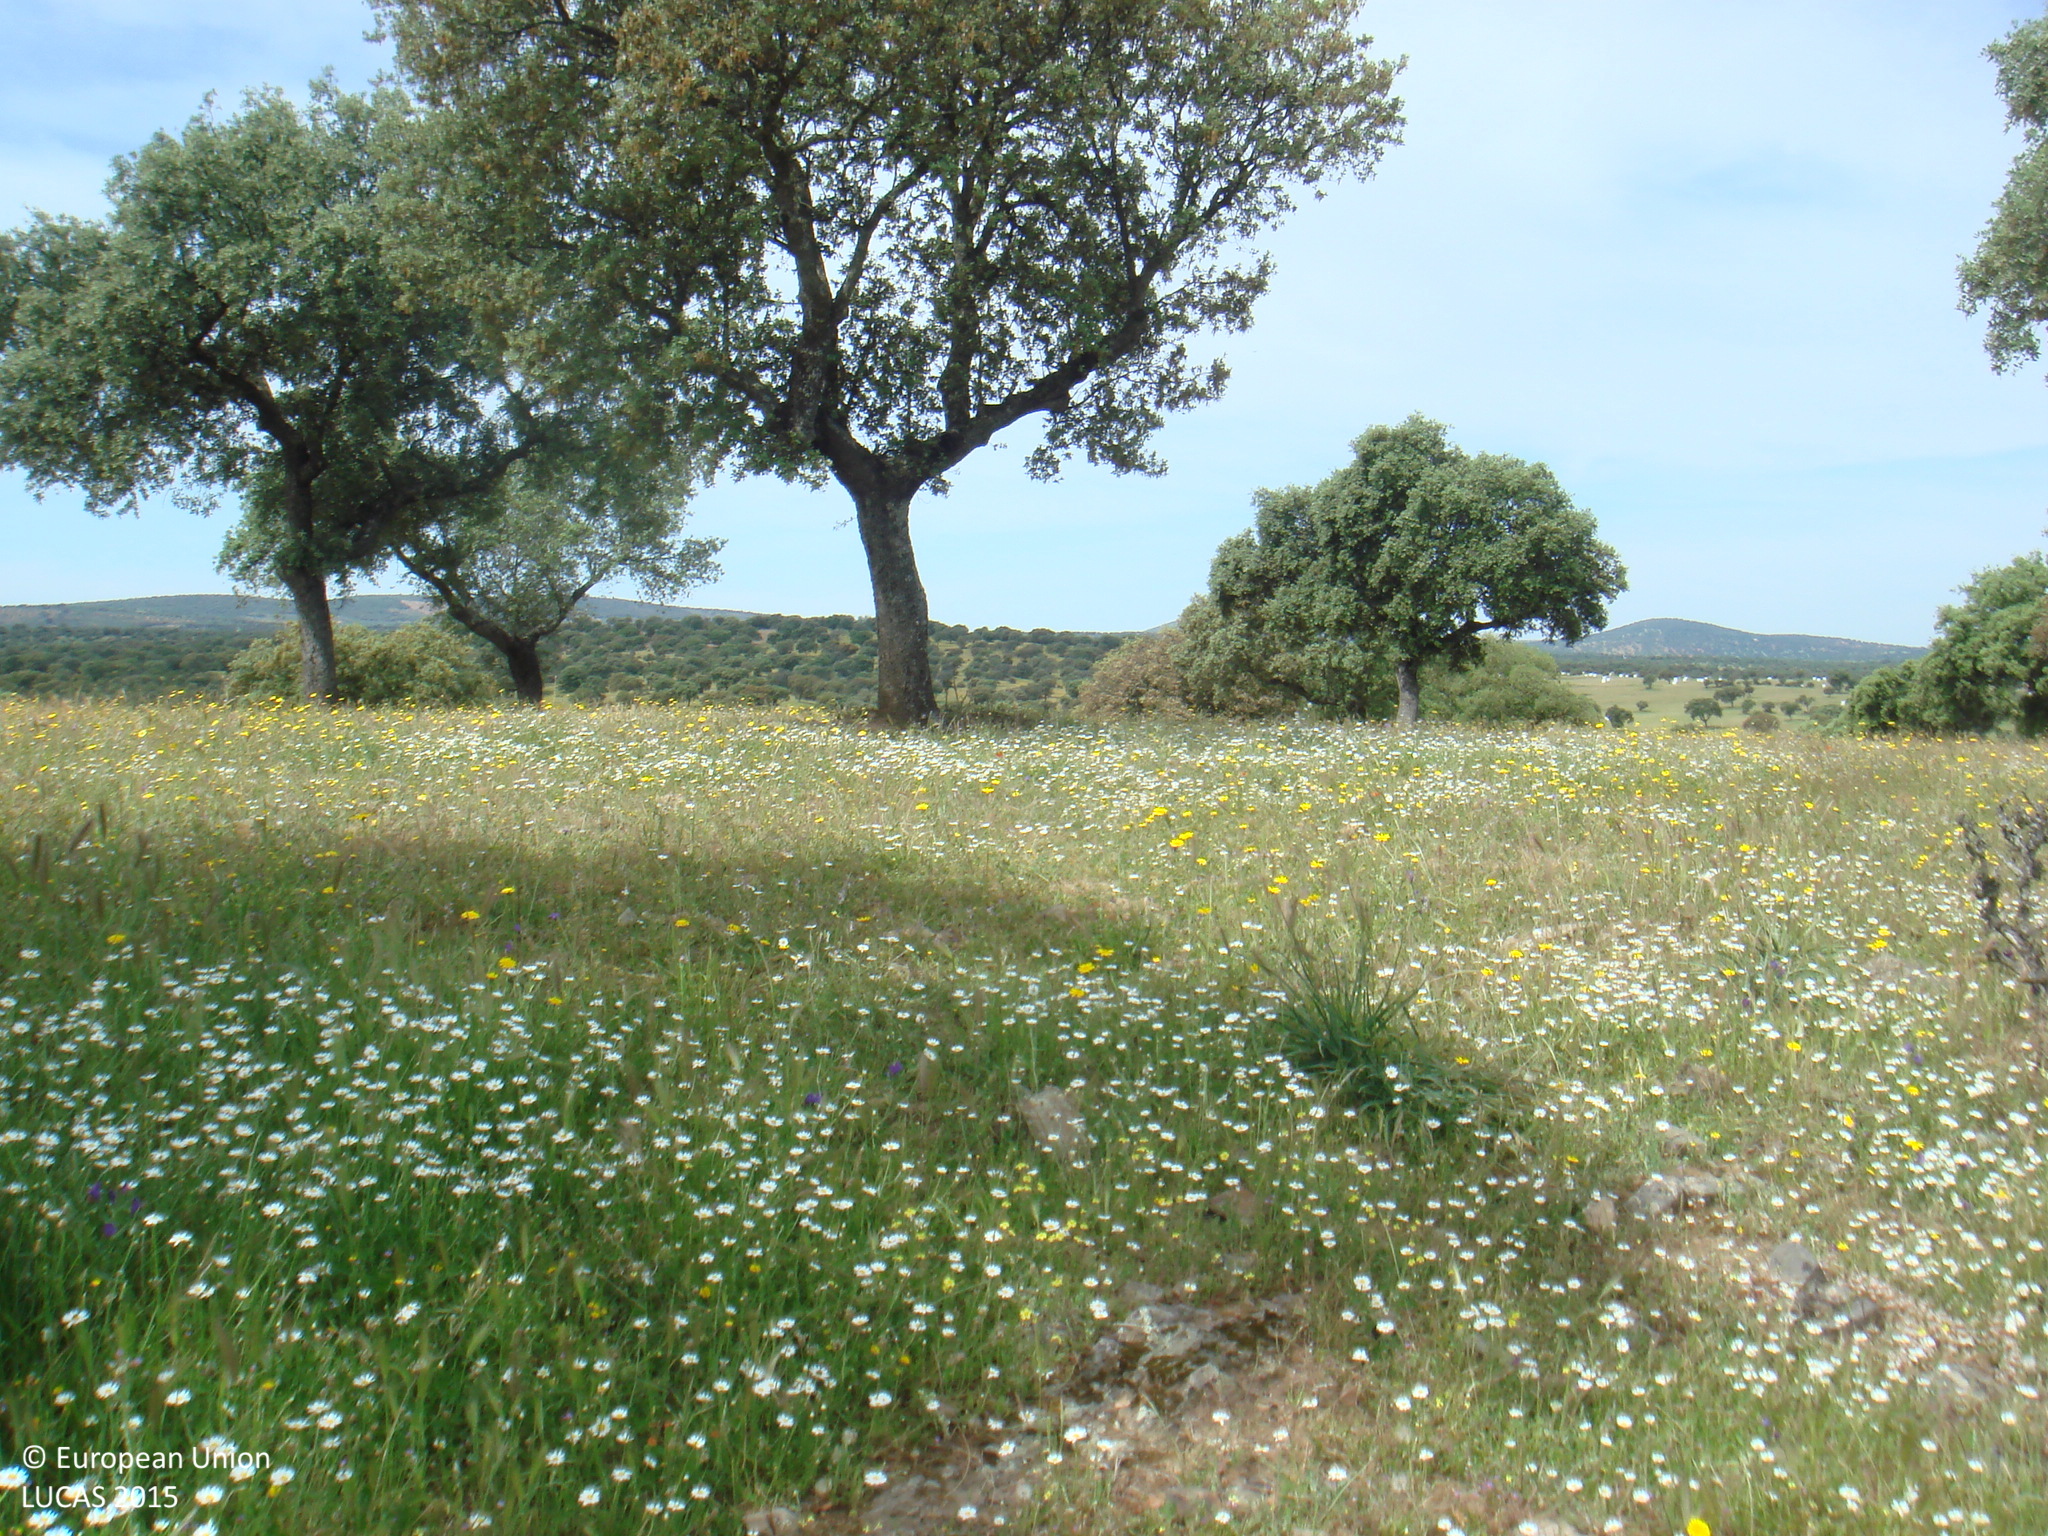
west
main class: Woodland
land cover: Broadleaved woodland
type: broadleaved evergreen forest
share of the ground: 25 - 50 %
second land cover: Grassland without tree/shrub cover
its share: > 75 %
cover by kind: herbaceous plants 70 %, broadleaved forest trees 30 %
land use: Forestry
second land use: Agriculture (excluding fallow land and kitchen gardens)
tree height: > 5 m
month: May
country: ES
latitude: 38.3775
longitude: -5.0796
